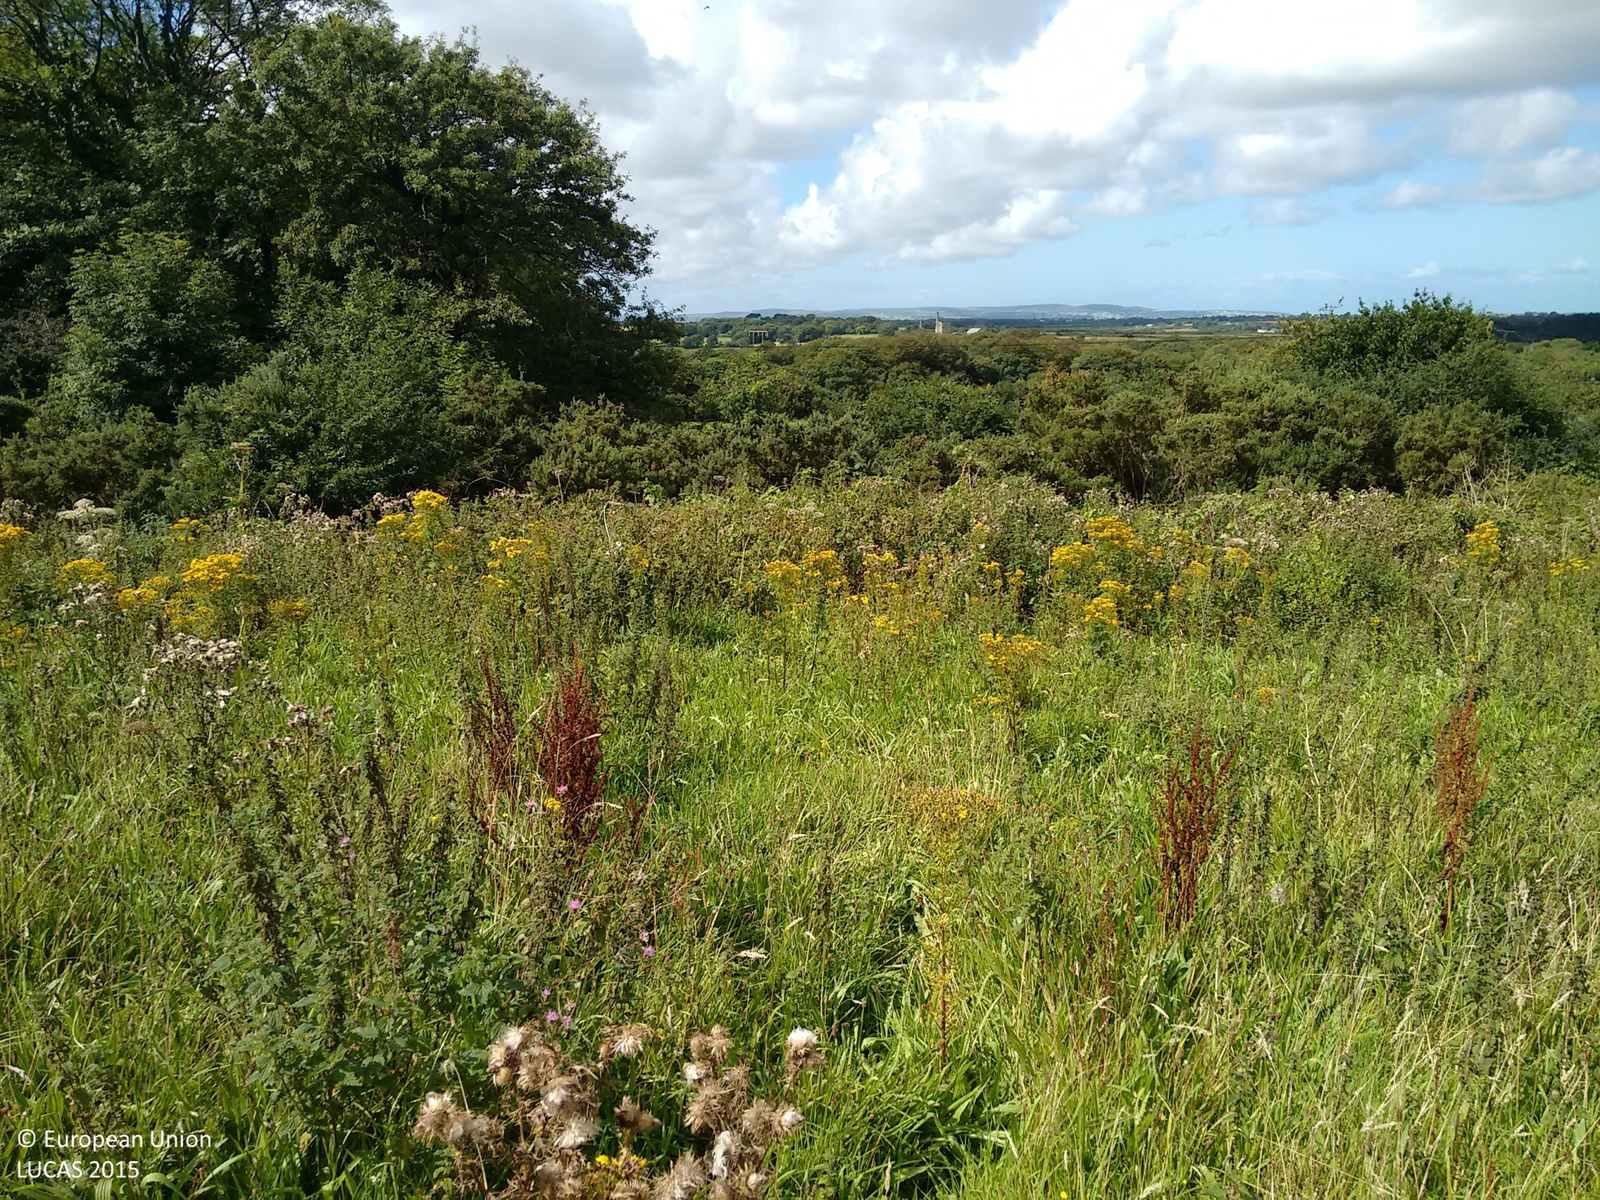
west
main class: Grassland
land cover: Grassland without tree/shrub cover
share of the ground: > 75 %
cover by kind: herbaceous plants 100 %
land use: Agriculture (excluding fallow land and kitchen gardens)
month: August
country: GB
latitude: 50.1882
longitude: -5.2910
